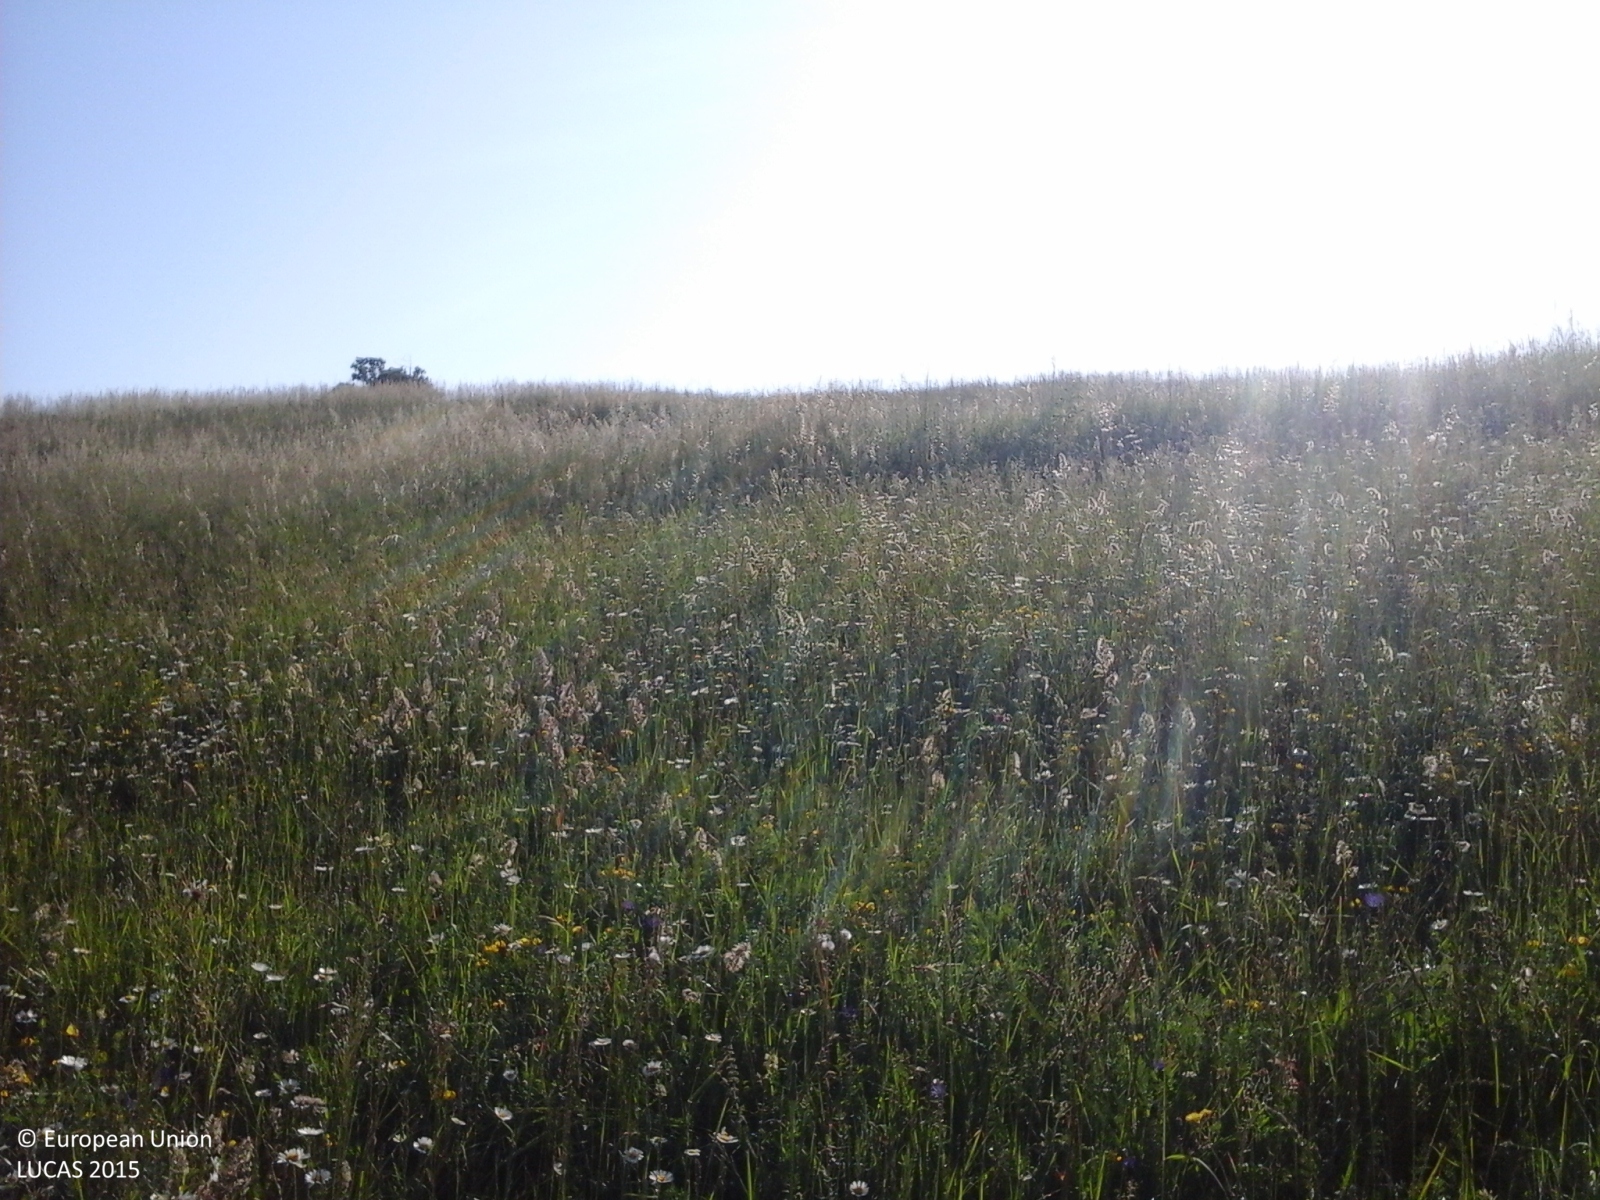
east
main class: Woodland
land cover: Broadleaved woodland
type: mesophytic deciduous forest
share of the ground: > 75 %
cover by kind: broadleaved forest trees 100 %
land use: Forestry
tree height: > 5 m
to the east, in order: Broadleaved woodland; Grassland without tree/shrub cover
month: May
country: IT
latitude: 44.4371
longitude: 10.8649
